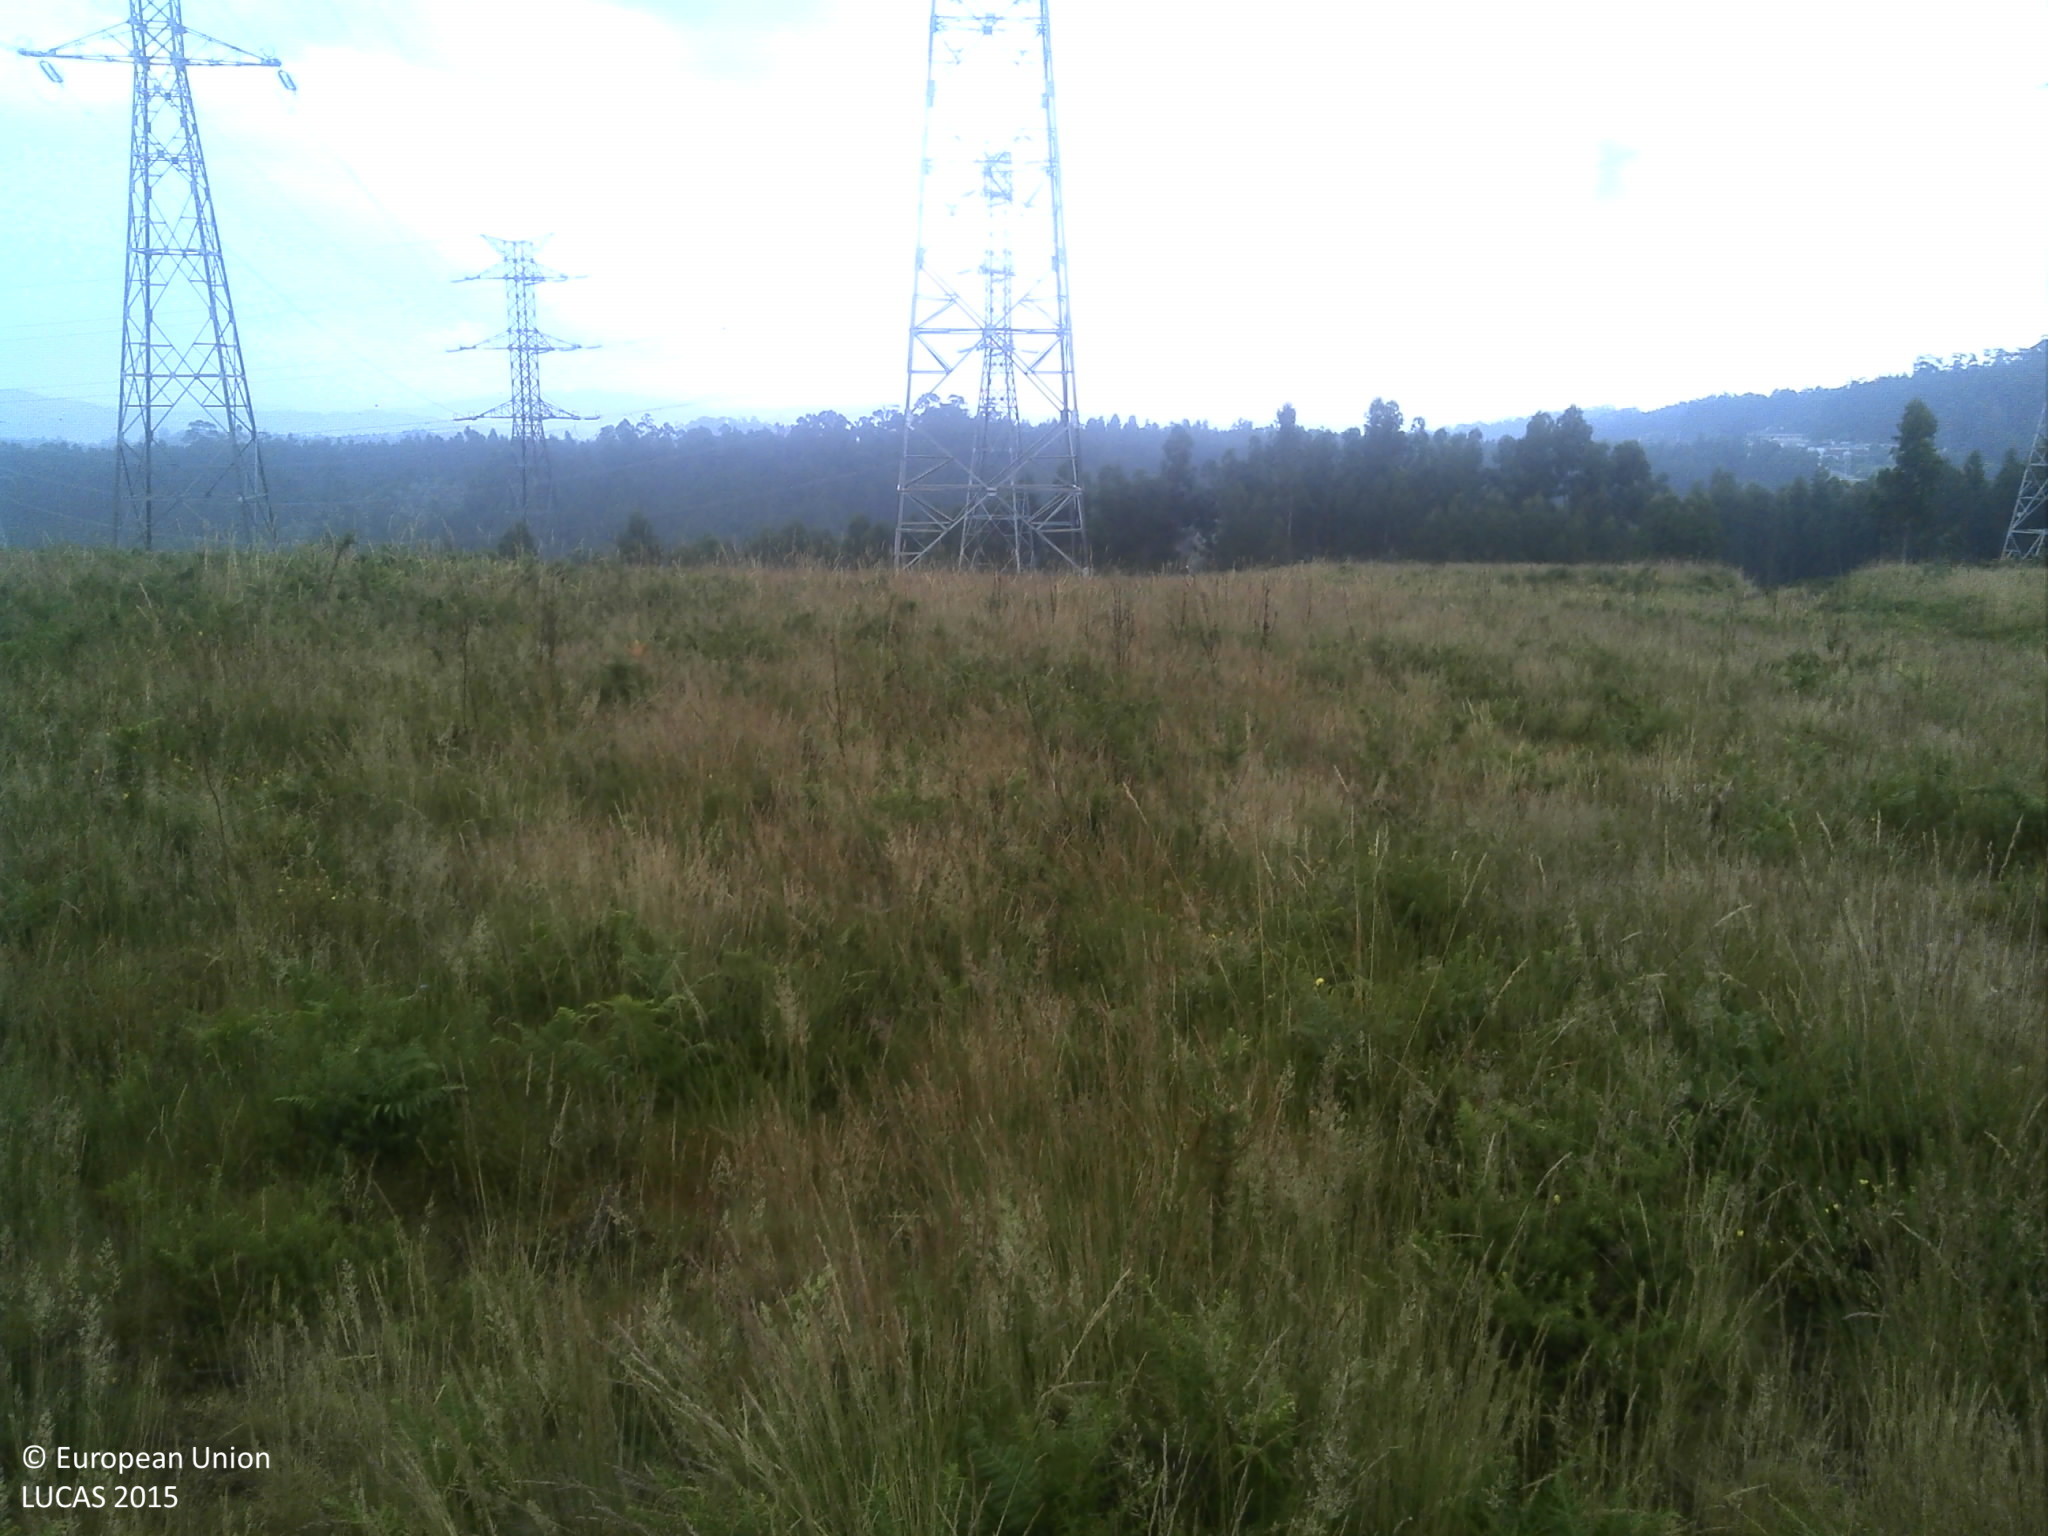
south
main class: Shrubland
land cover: Shrubland without tree cover
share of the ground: > 75 %
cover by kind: shrubs 55 %, herbaceous plants 40 %, unconsolidated bare surface 5 %
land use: Agriculture (excluding fallow land and kitchen gardens)
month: June
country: PT
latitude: 41.5755
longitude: -8.3212
